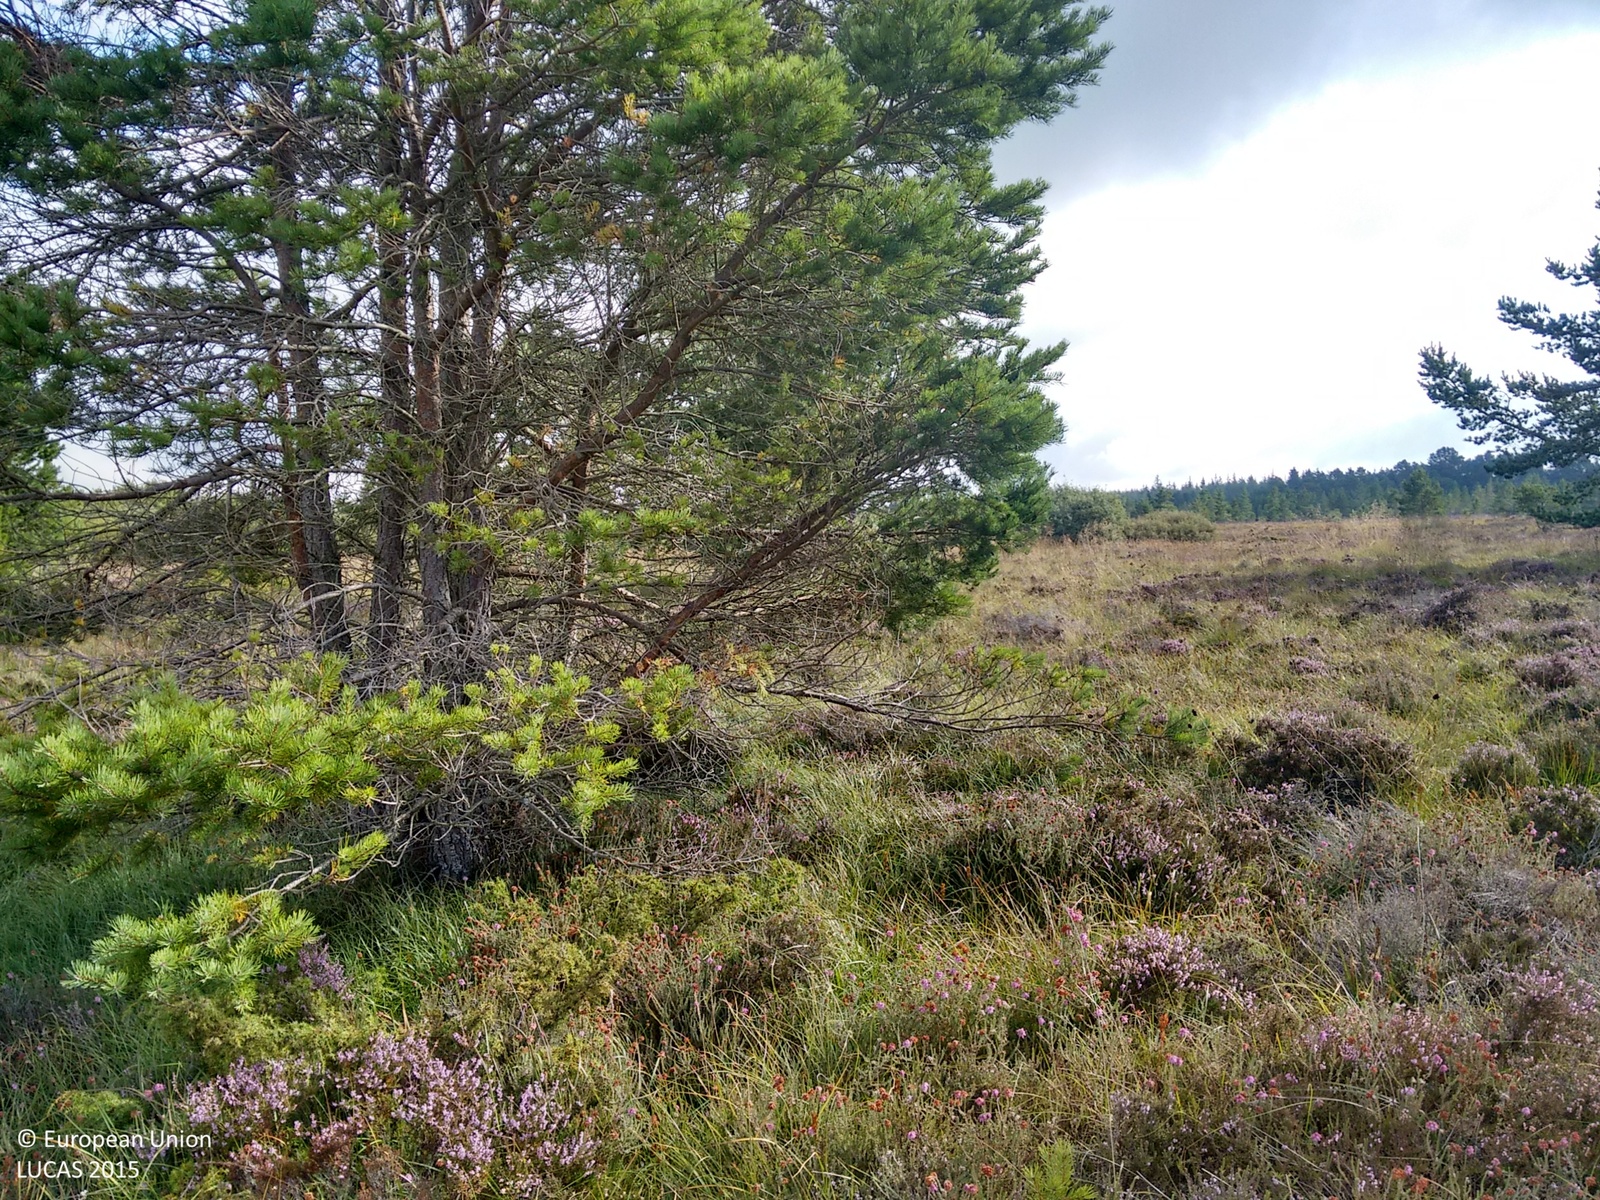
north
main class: Woodland
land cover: Pine dominated coniferous woodland
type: exotic forest
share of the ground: > 75 %
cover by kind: shrubs 40 %, coniferous forest trees 30 %, herbaceous plants 20 %, lichens and mosses 10 %
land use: Semi-natural and natural areas not in use
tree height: < 5 m
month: September
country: GB
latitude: 57.4457
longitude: -4.1638
